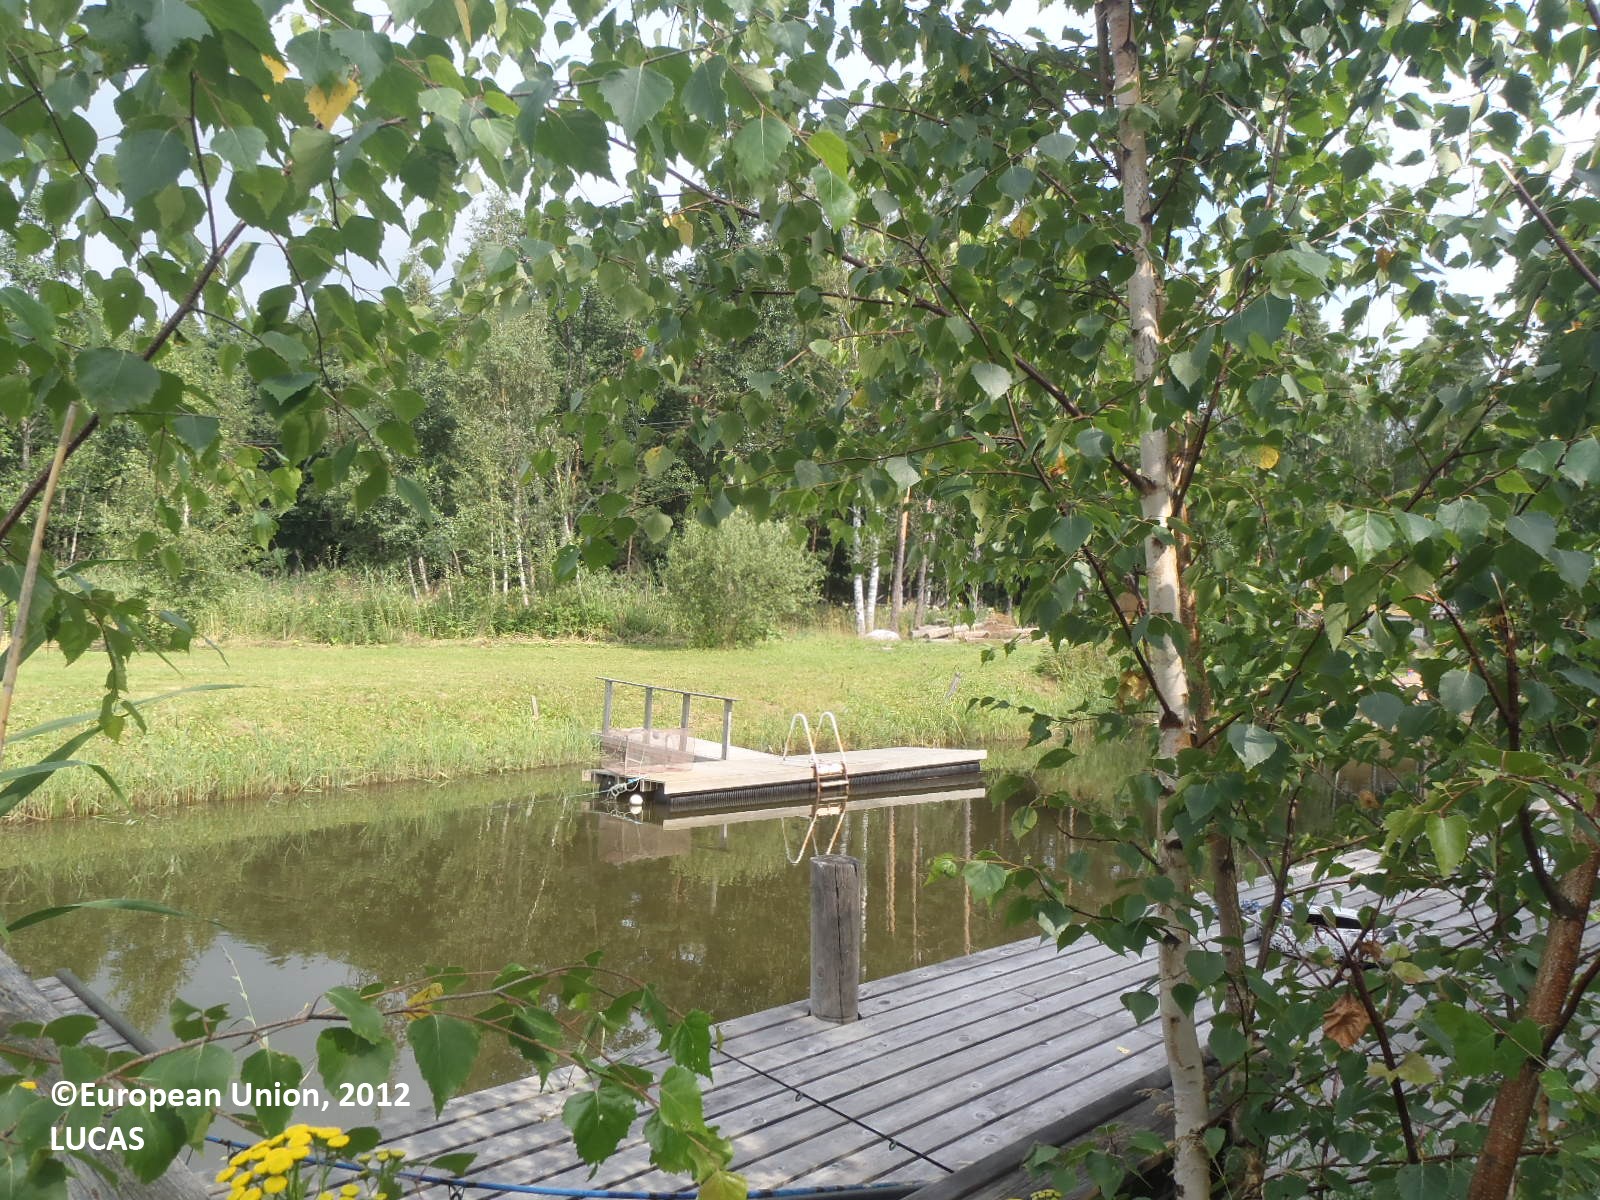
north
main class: Grassland
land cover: Grassland without tree/shrub cover
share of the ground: > 75 %
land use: Amenities, museums, leisure
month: July
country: FI
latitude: 60.5567
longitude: 21.8235
